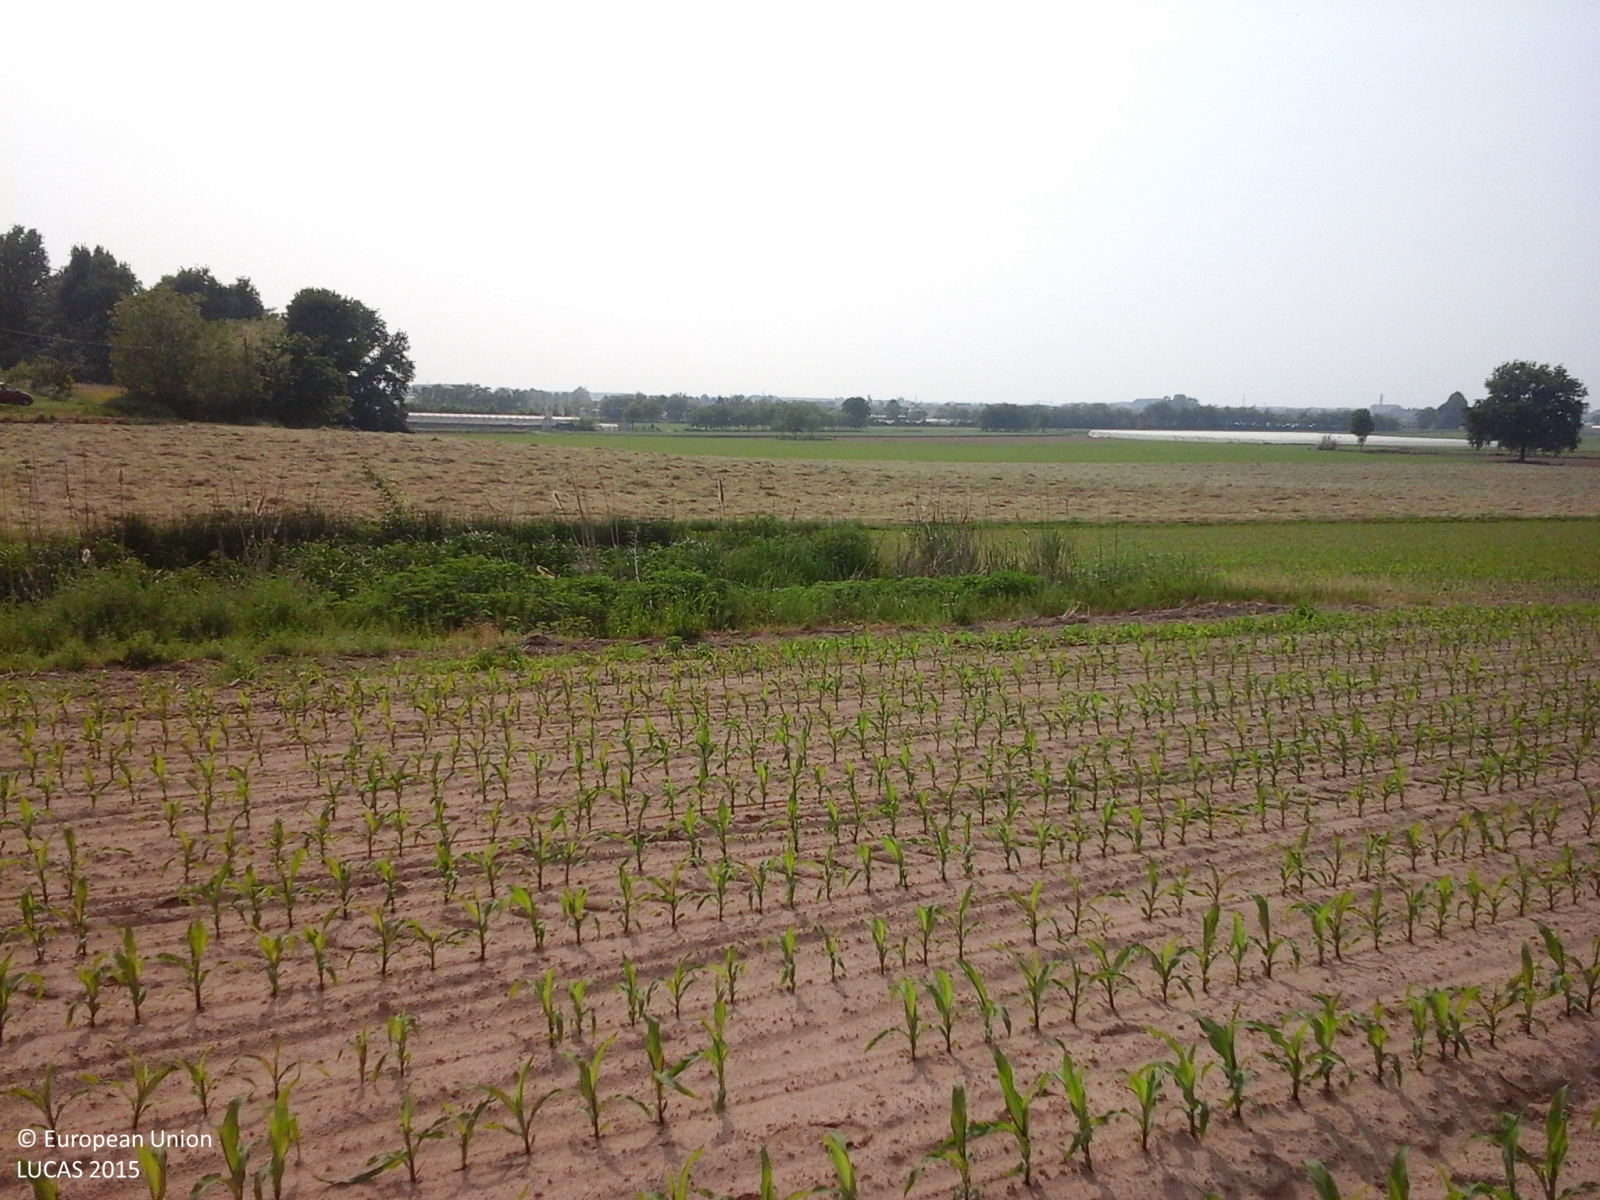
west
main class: Cropland
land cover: Maize
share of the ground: < 10 %
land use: Agriculture (excluding fallow land and kitchen gardens)
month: May
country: IT
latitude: 44.8316
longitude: 7.7654
